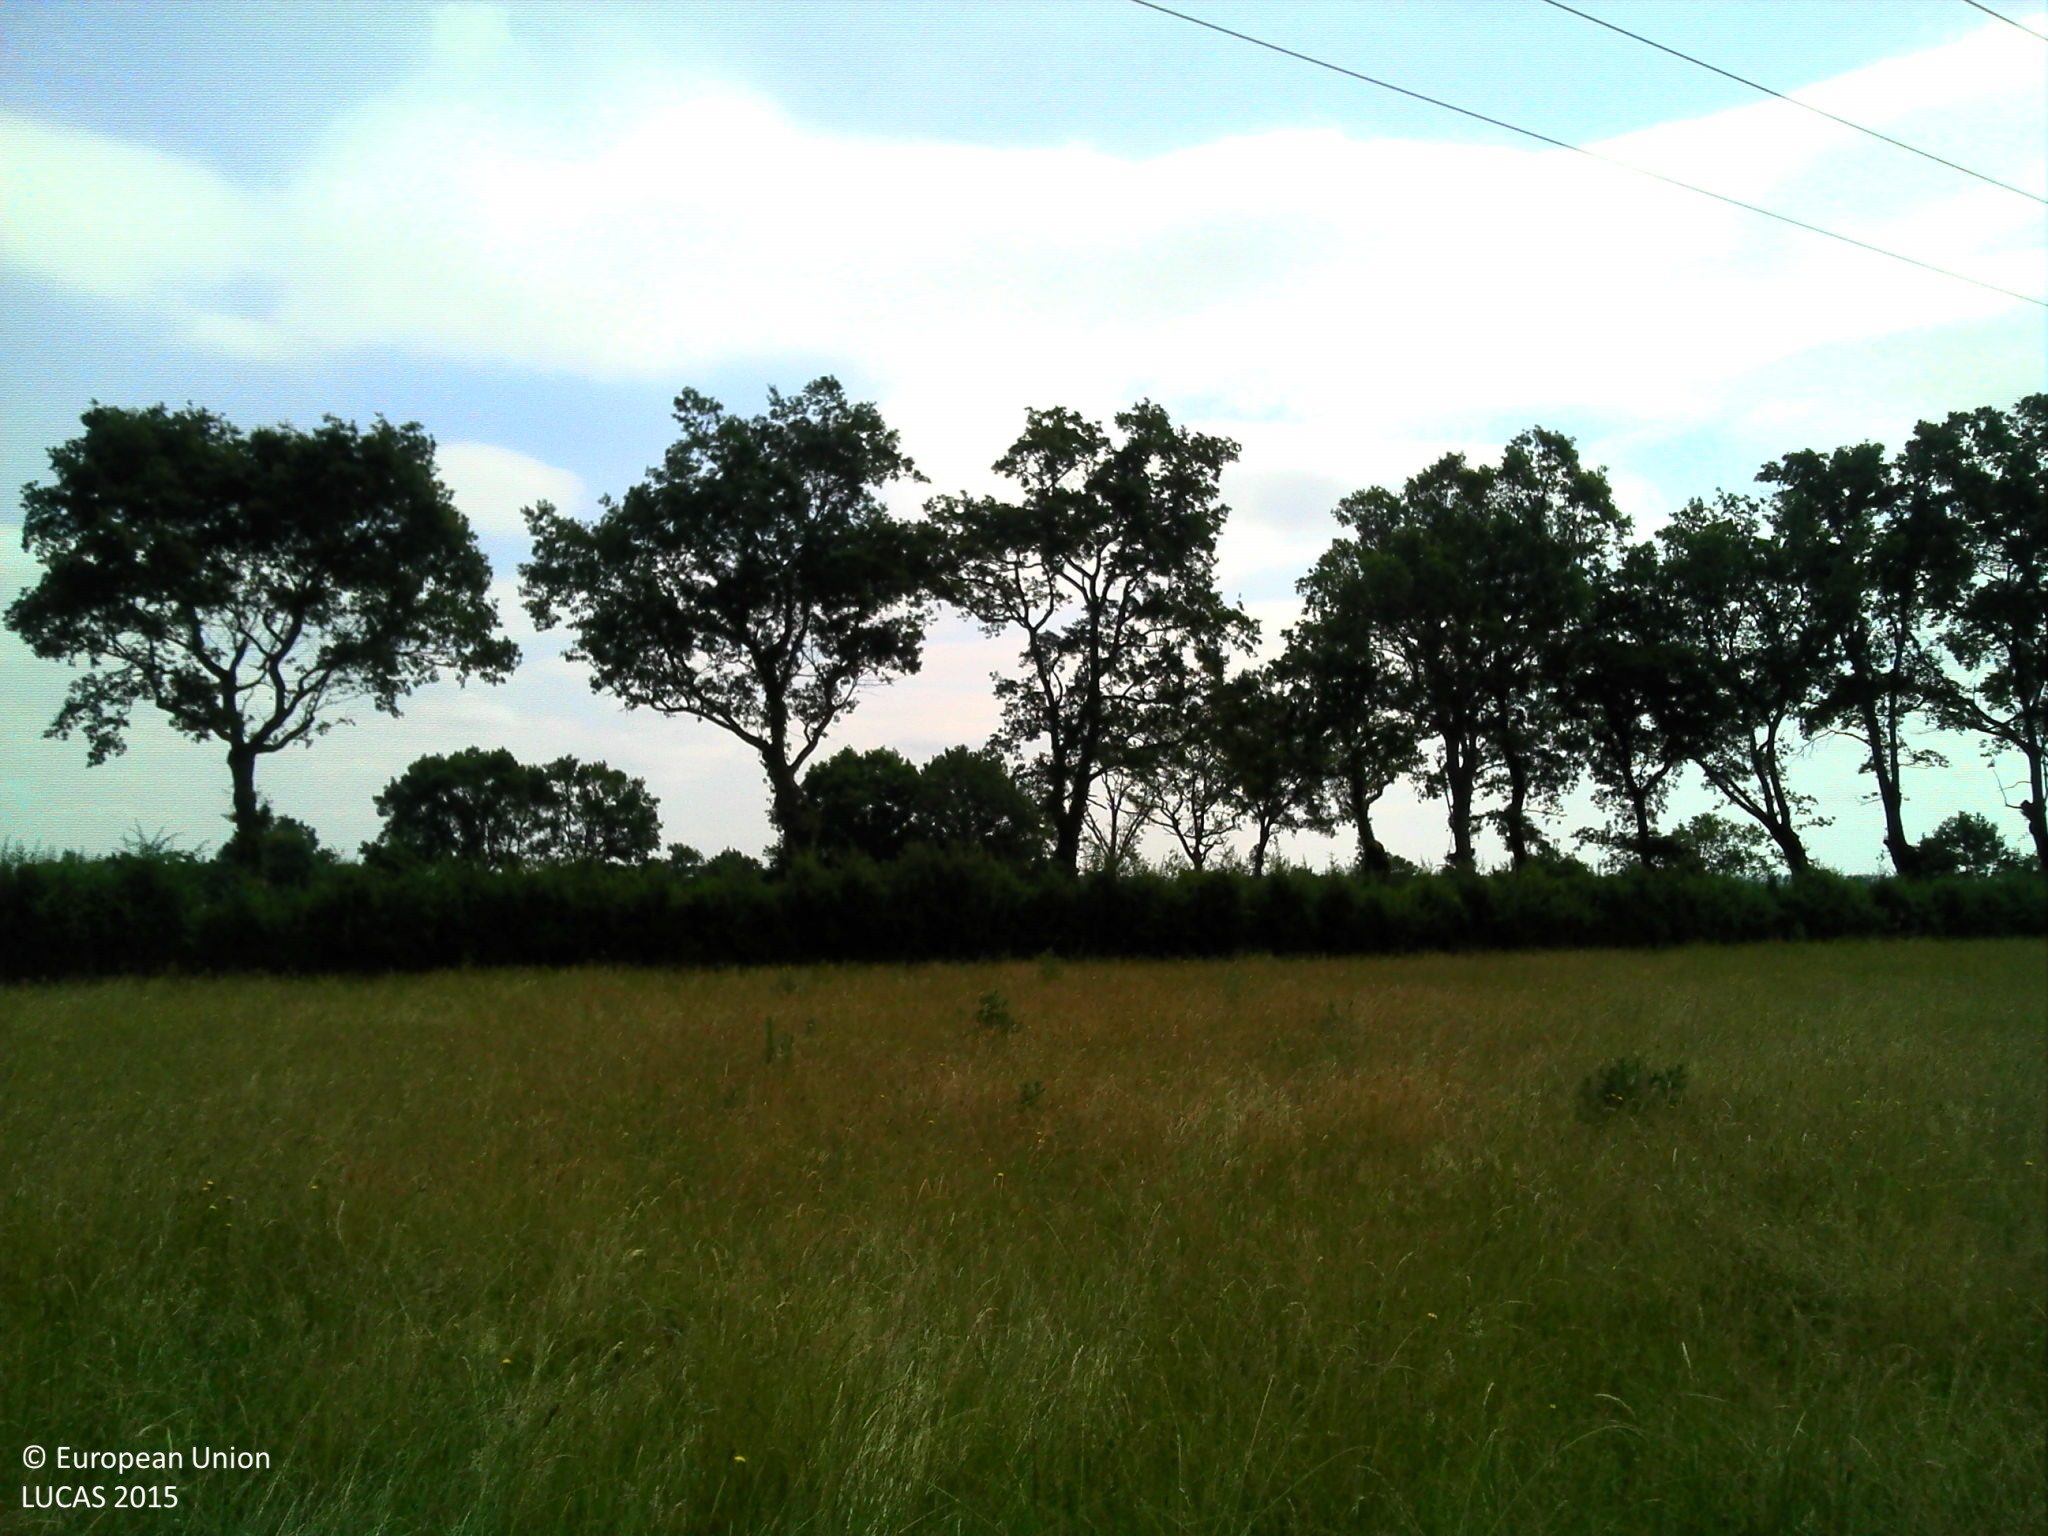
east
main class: Grassland
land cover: Grassland without tree/shrub cover
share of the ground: > 75 %
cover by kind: herbaceous plants 100 %
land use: Agriculture (excluding fallow land and kitchen gardens)
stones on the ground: < 10 %
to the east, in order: Grassland without tree/shrub cover; Electric lines; Grassland without tree/shrub cover; Fences; Managed hedges; Tracks; Fences; Managed hedges; Grassland without tree/shrub cover; Fences; Ditches and canals; Fences; Grassland without tree/shrub cover; Managed hedges; Fences; Grassland without tree/shrub cover
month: June
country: FR
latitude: 46.3835
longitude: 2.8586
